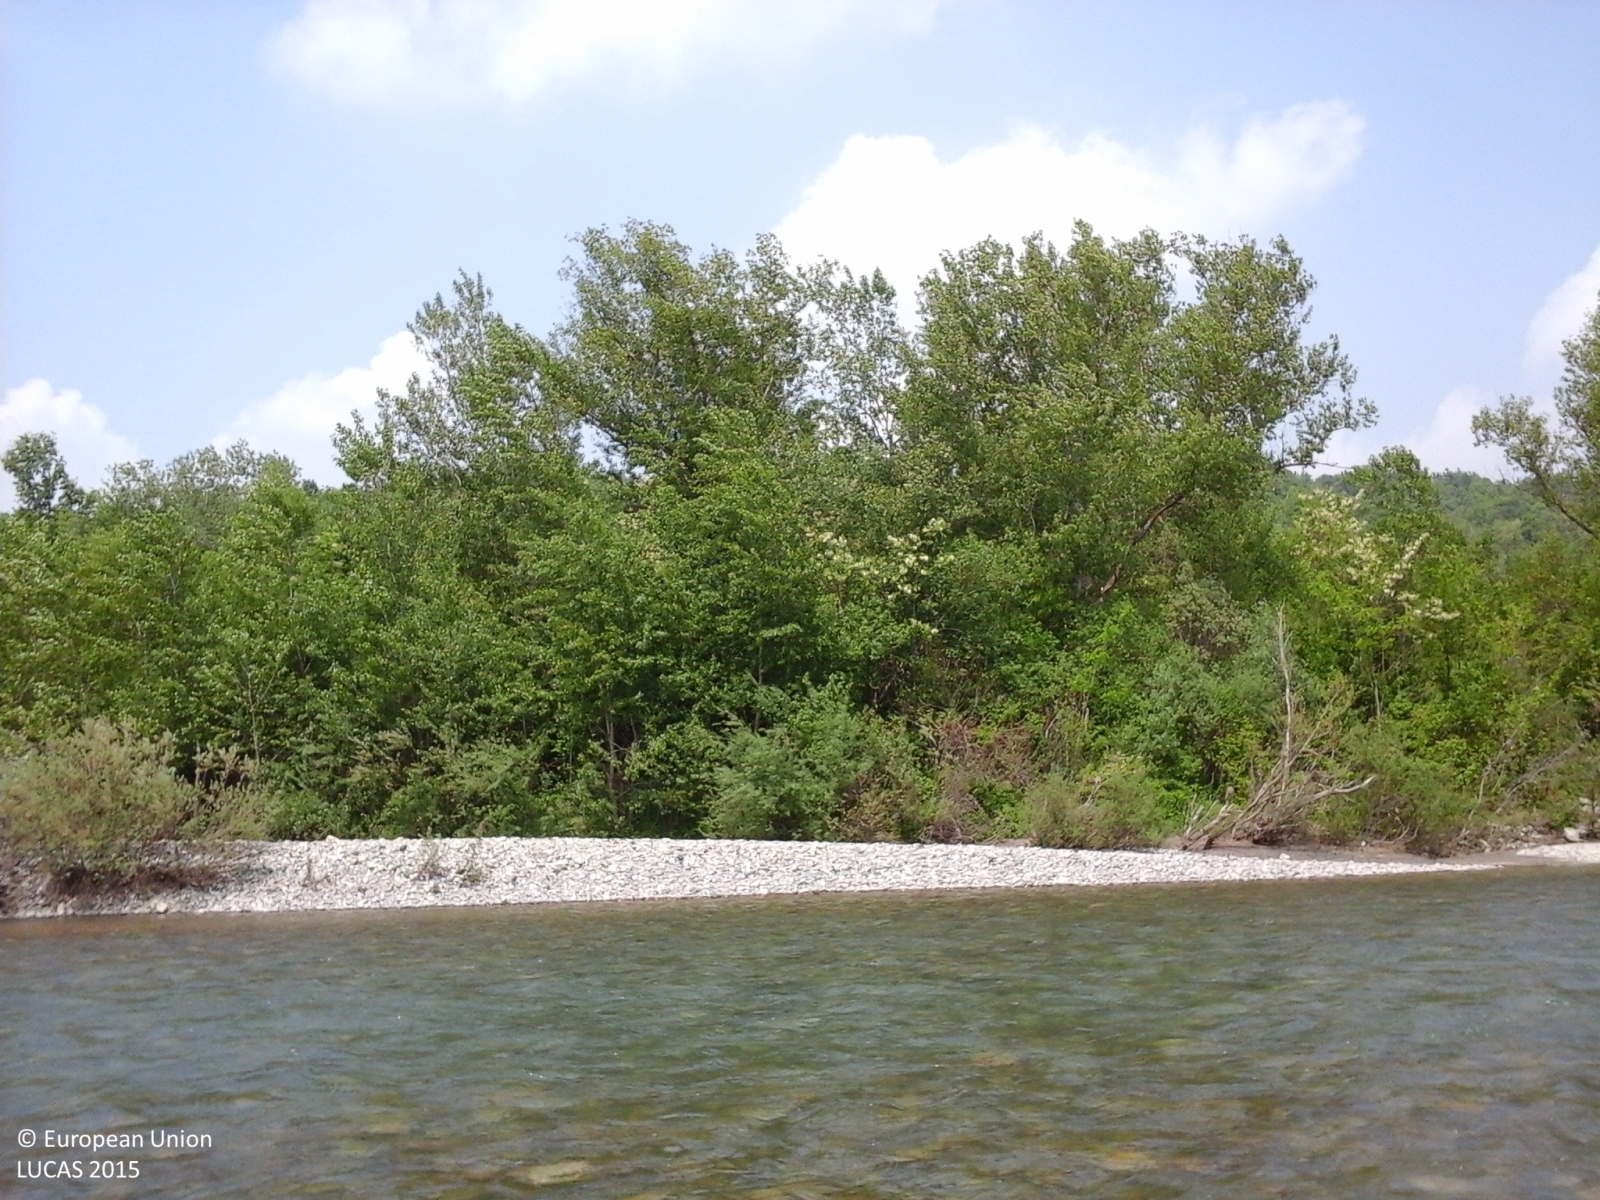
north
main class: Woodland
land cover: Broadleaved woodland
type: mesophytic deciduous forest
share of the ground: > 75 %
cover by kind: broadleaved forest trees 85 %, shrubs 15 %
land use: Forestry
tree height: > 5 m
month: May
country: IT
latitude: 44.8180
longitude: 9.4573
